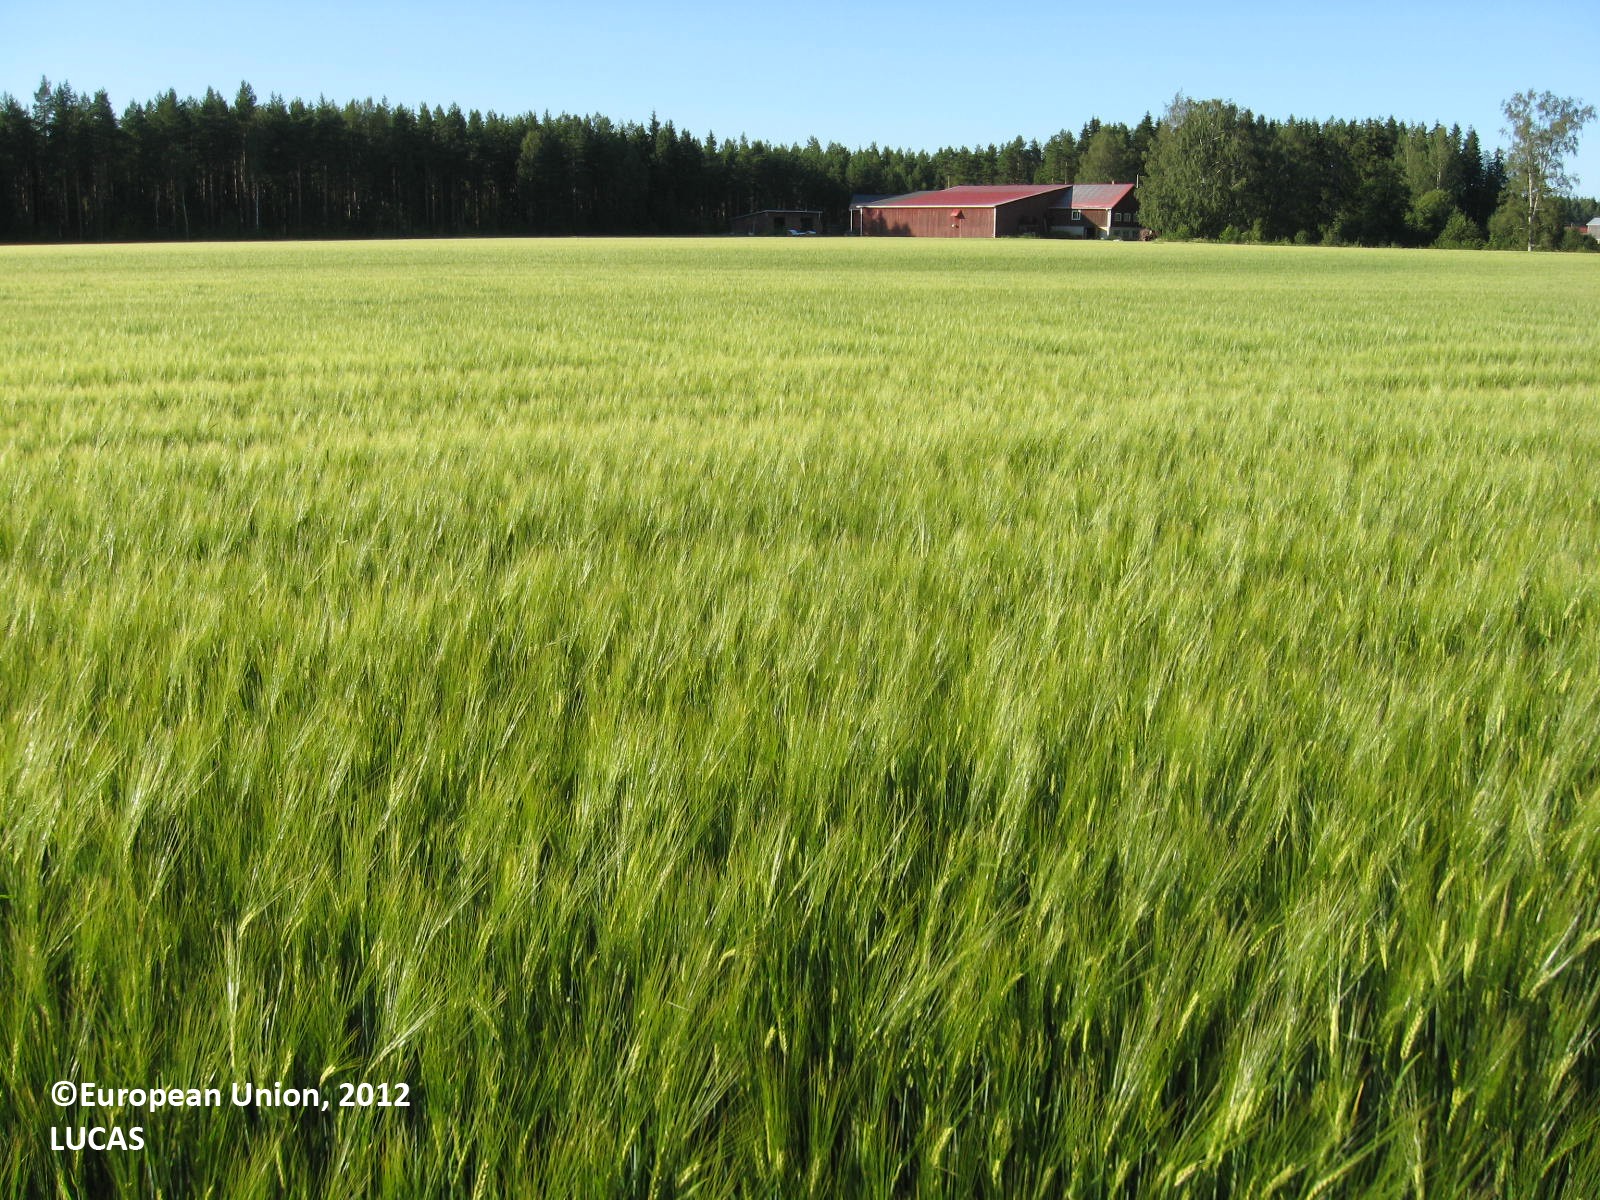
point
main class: Cropland
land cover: Barley
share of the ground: > 75 %
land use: Agriculture (excluding fallow land and kitchen gardens)
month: July
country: FI
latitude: 62.0725
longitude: 22.4802
